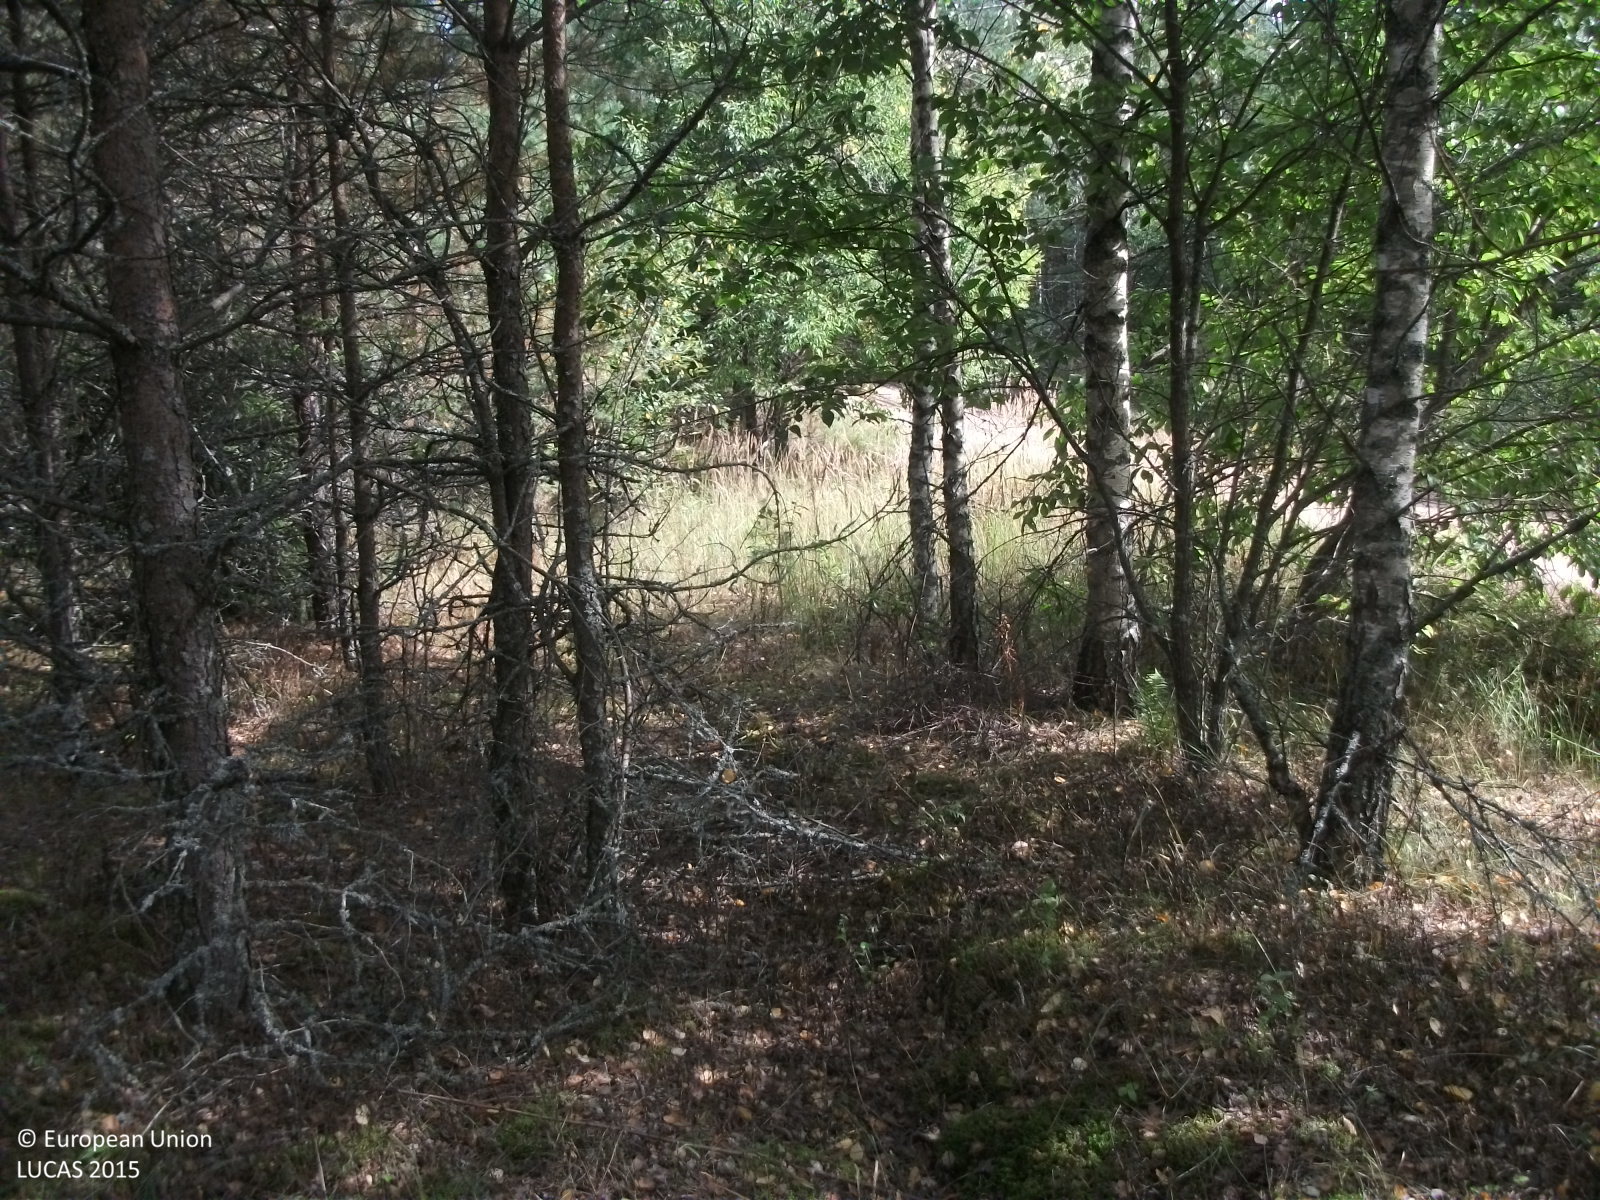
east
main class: Woodland
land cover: Pine dominated coniferous woodland
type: hemiboreal forest and nemoral coniferous forest and mixed broadleaved-coniferous forest
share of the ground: 50 - 75 %
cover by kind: coniferous forest trees 70 %, lichens and mosses 25 %, herbaceous plants 5 %
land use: Forestry
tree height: > 5 m
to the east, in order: Pine dominated coniferous woodland; Grass margins; Paved roads, cycling and walking lanes; Shruby margins; Pine dominated coniferous woodland; Shrubland with sparse tree cover; Tracks; Grassland with sparse tree/shrub cover
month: September
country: LV
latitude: 56.5760
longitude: 26.1047
